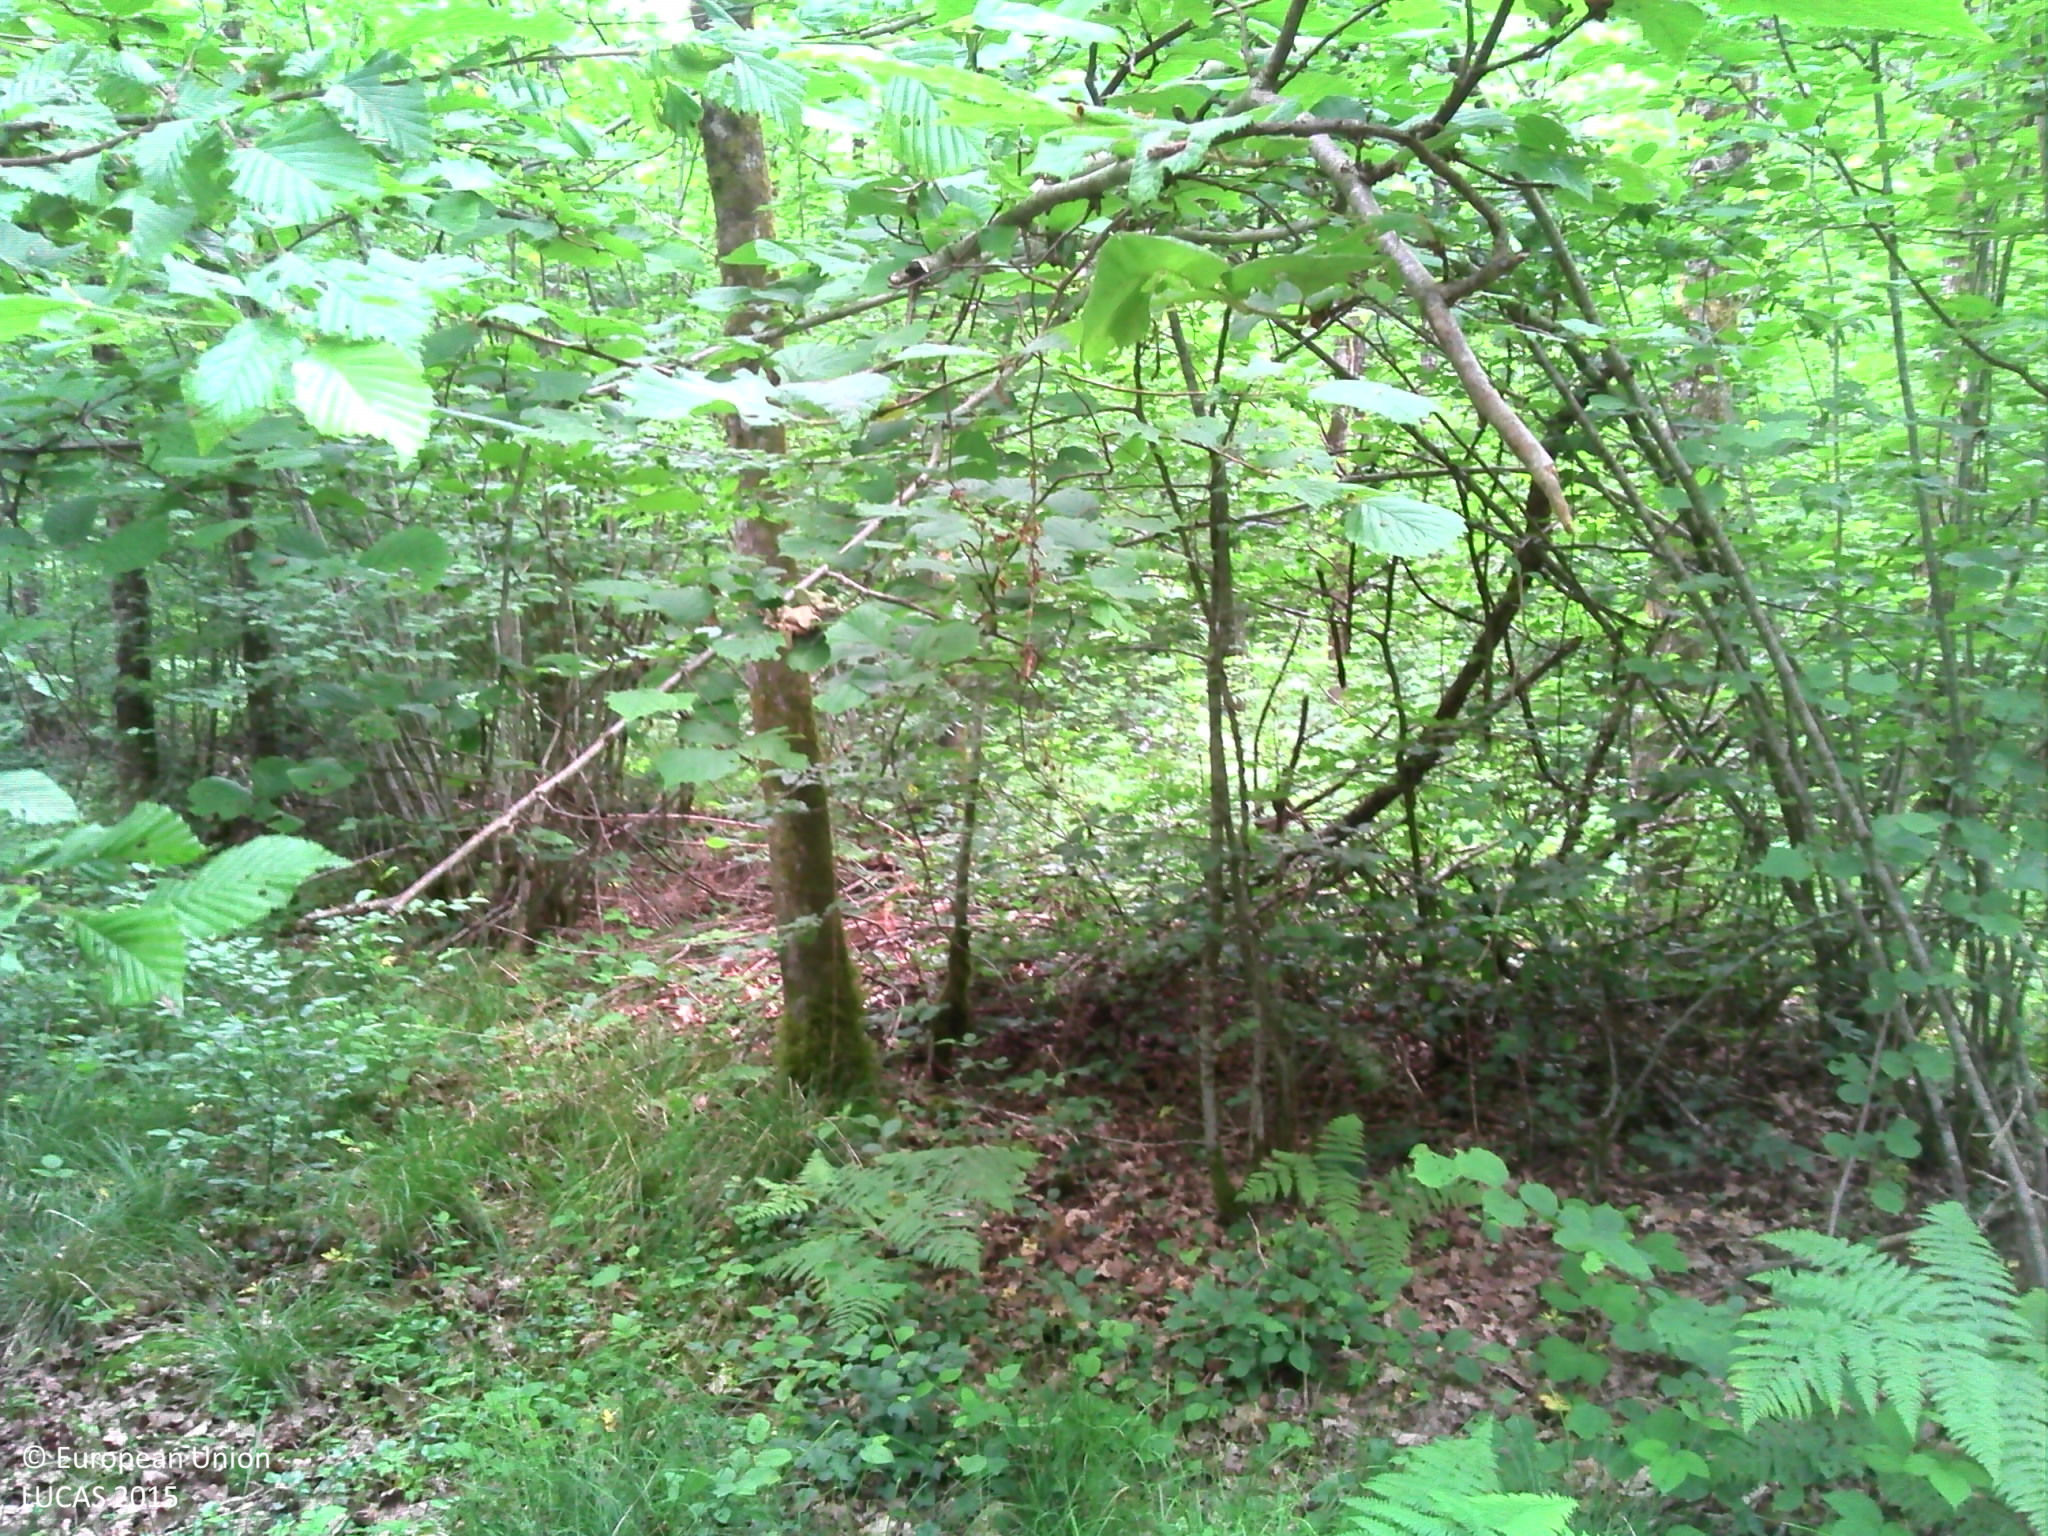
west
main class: Woodland
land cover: Broadleaved woodland
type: mesophytic deciduous forest
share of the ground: > 75 %
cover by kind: broadleaved forest trees 90 %, herbaceous plants 10 %
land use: Forestry
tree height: > 5 m
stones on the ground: < 10 %
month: June
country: FR
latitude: 47.8004
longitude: 6.2761
